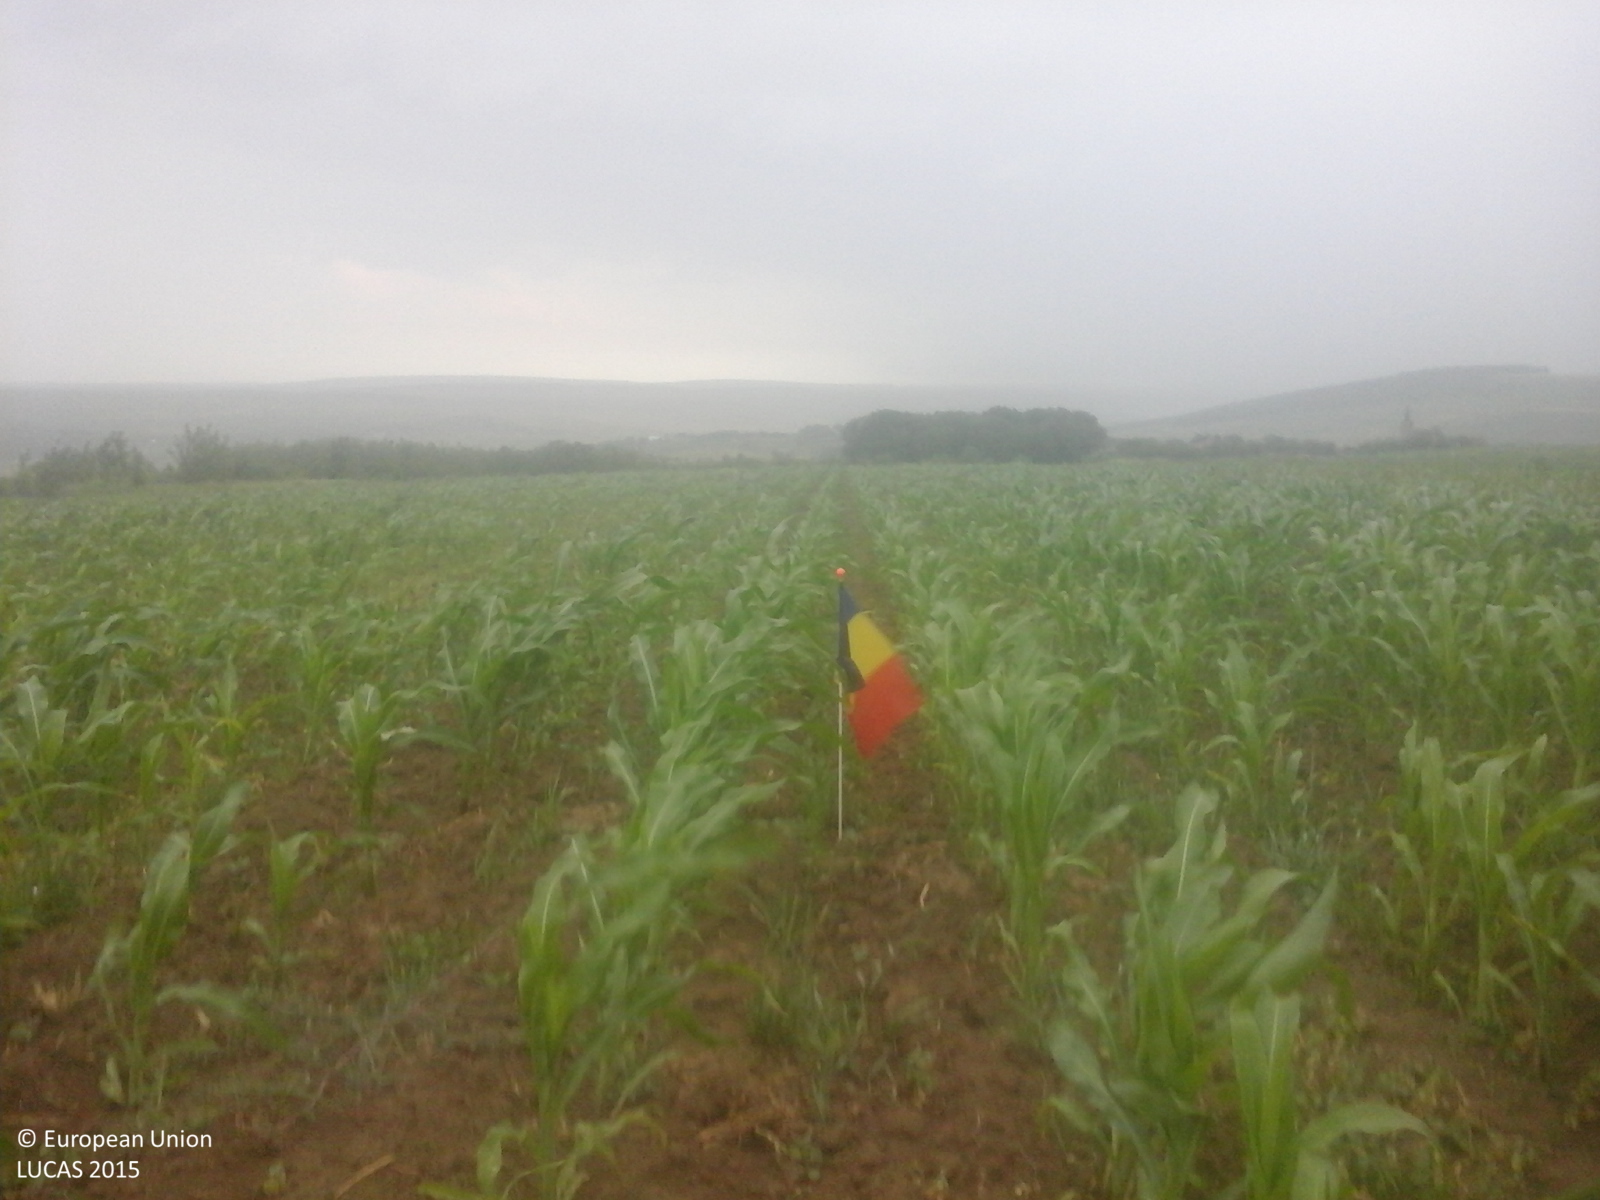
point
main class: Cropland
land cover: Maize
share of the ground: 50 - 75 %
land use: Agriculture (excluding fallow land and kitchen gardens)
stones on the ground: < 10 %
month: June
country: RO
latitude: 47.6772
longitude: 26.7881
